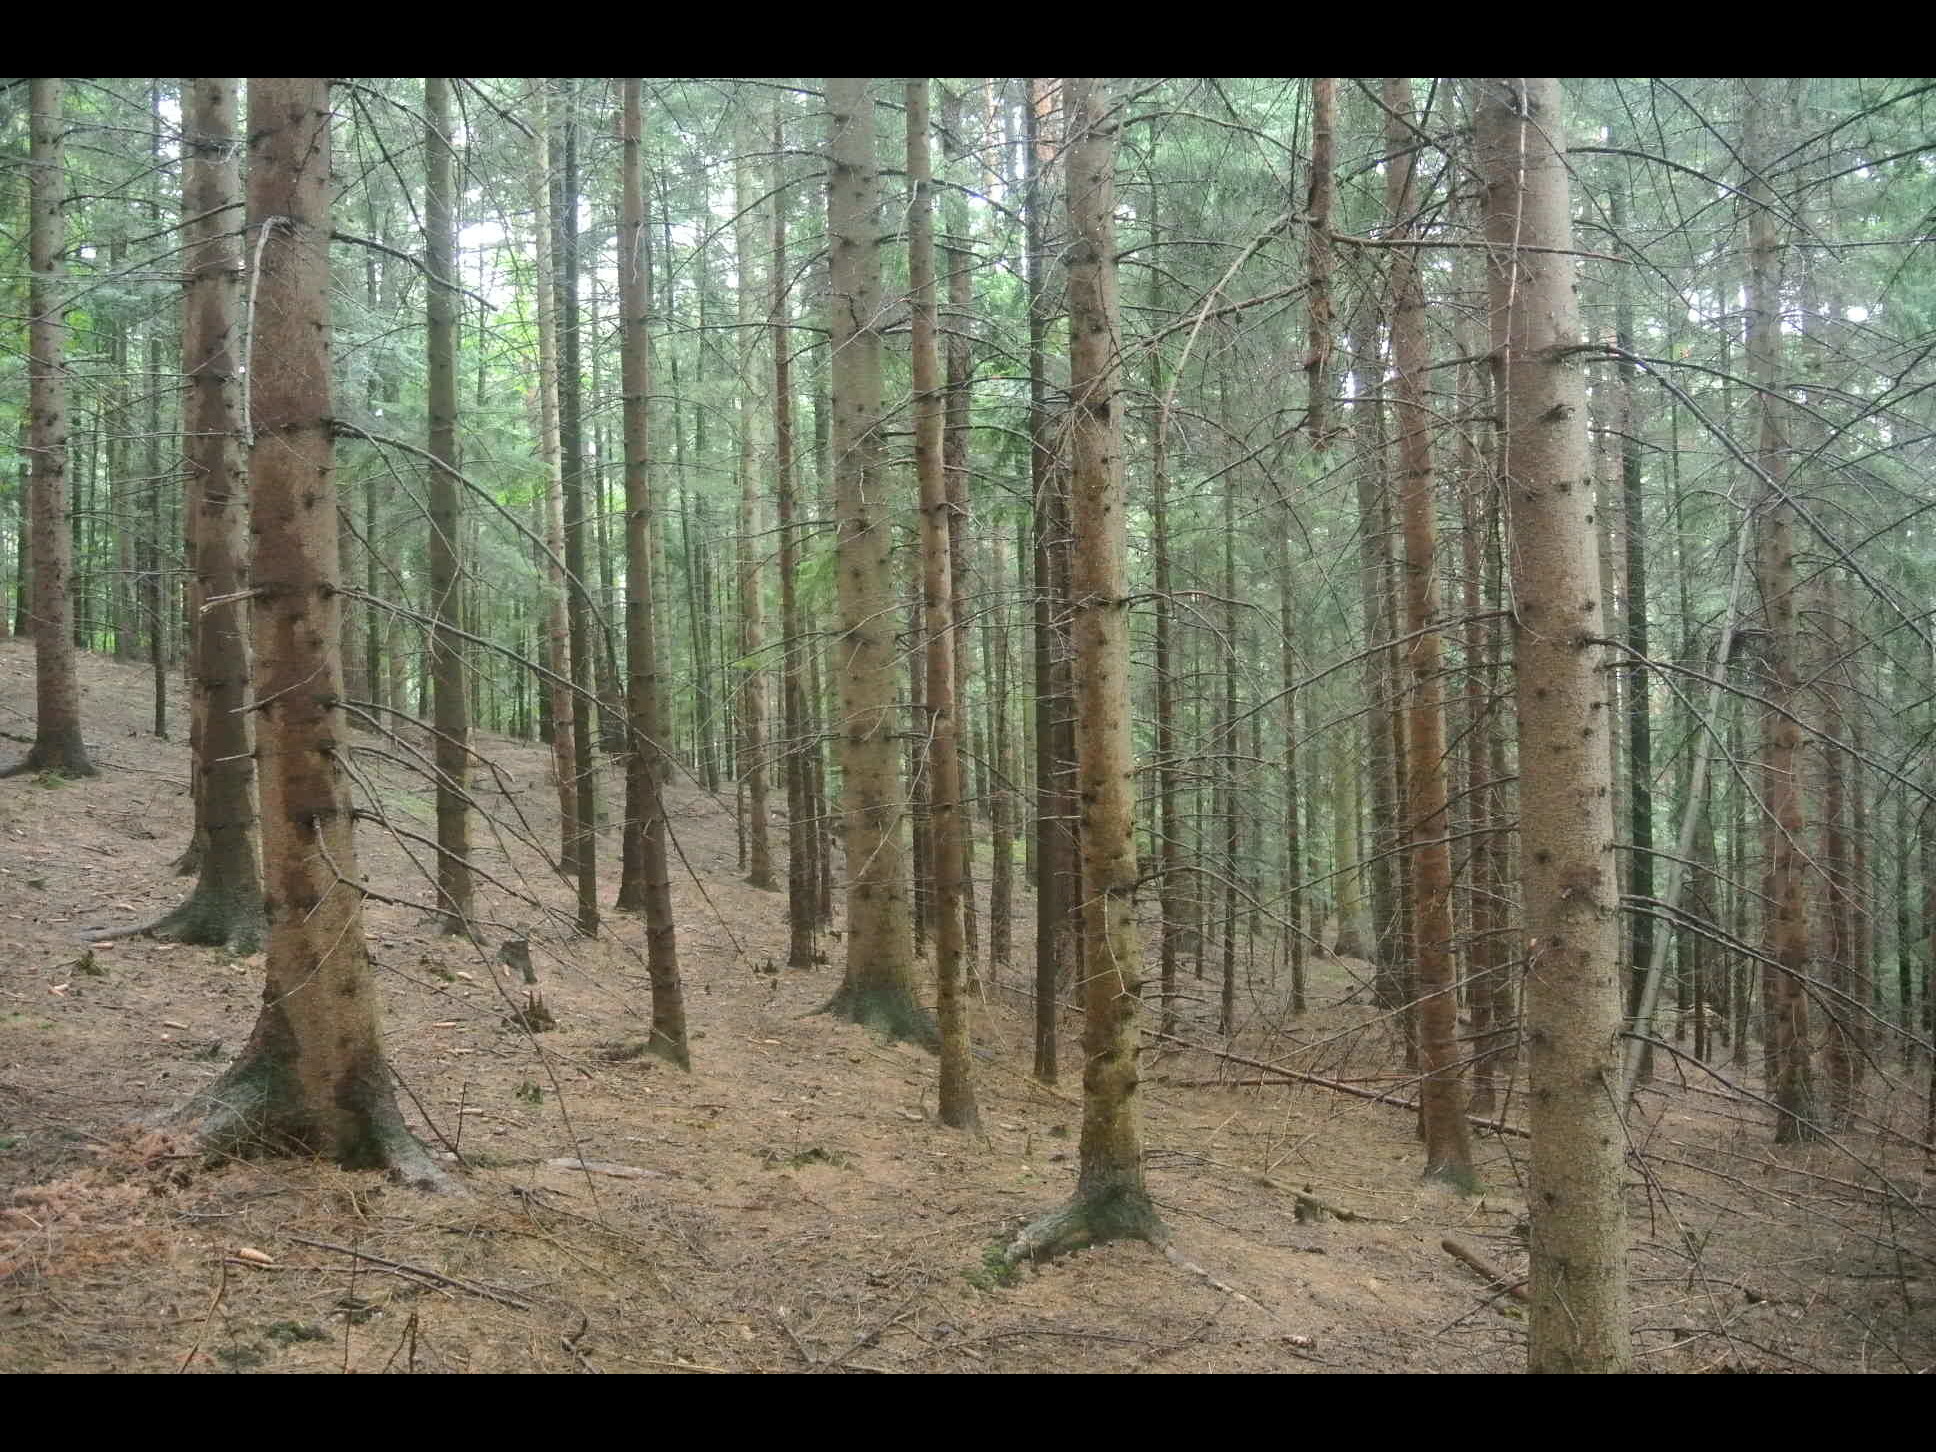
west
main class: Woodland
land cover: Spruce dominated coniferous woodland
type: alpine coniferous forest
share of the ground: > 75 %
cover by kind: coniferous forest trees 100 %
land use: Forestry
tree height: > 5 m
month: July
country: AT
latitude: 47.4566
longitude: 16.1439
